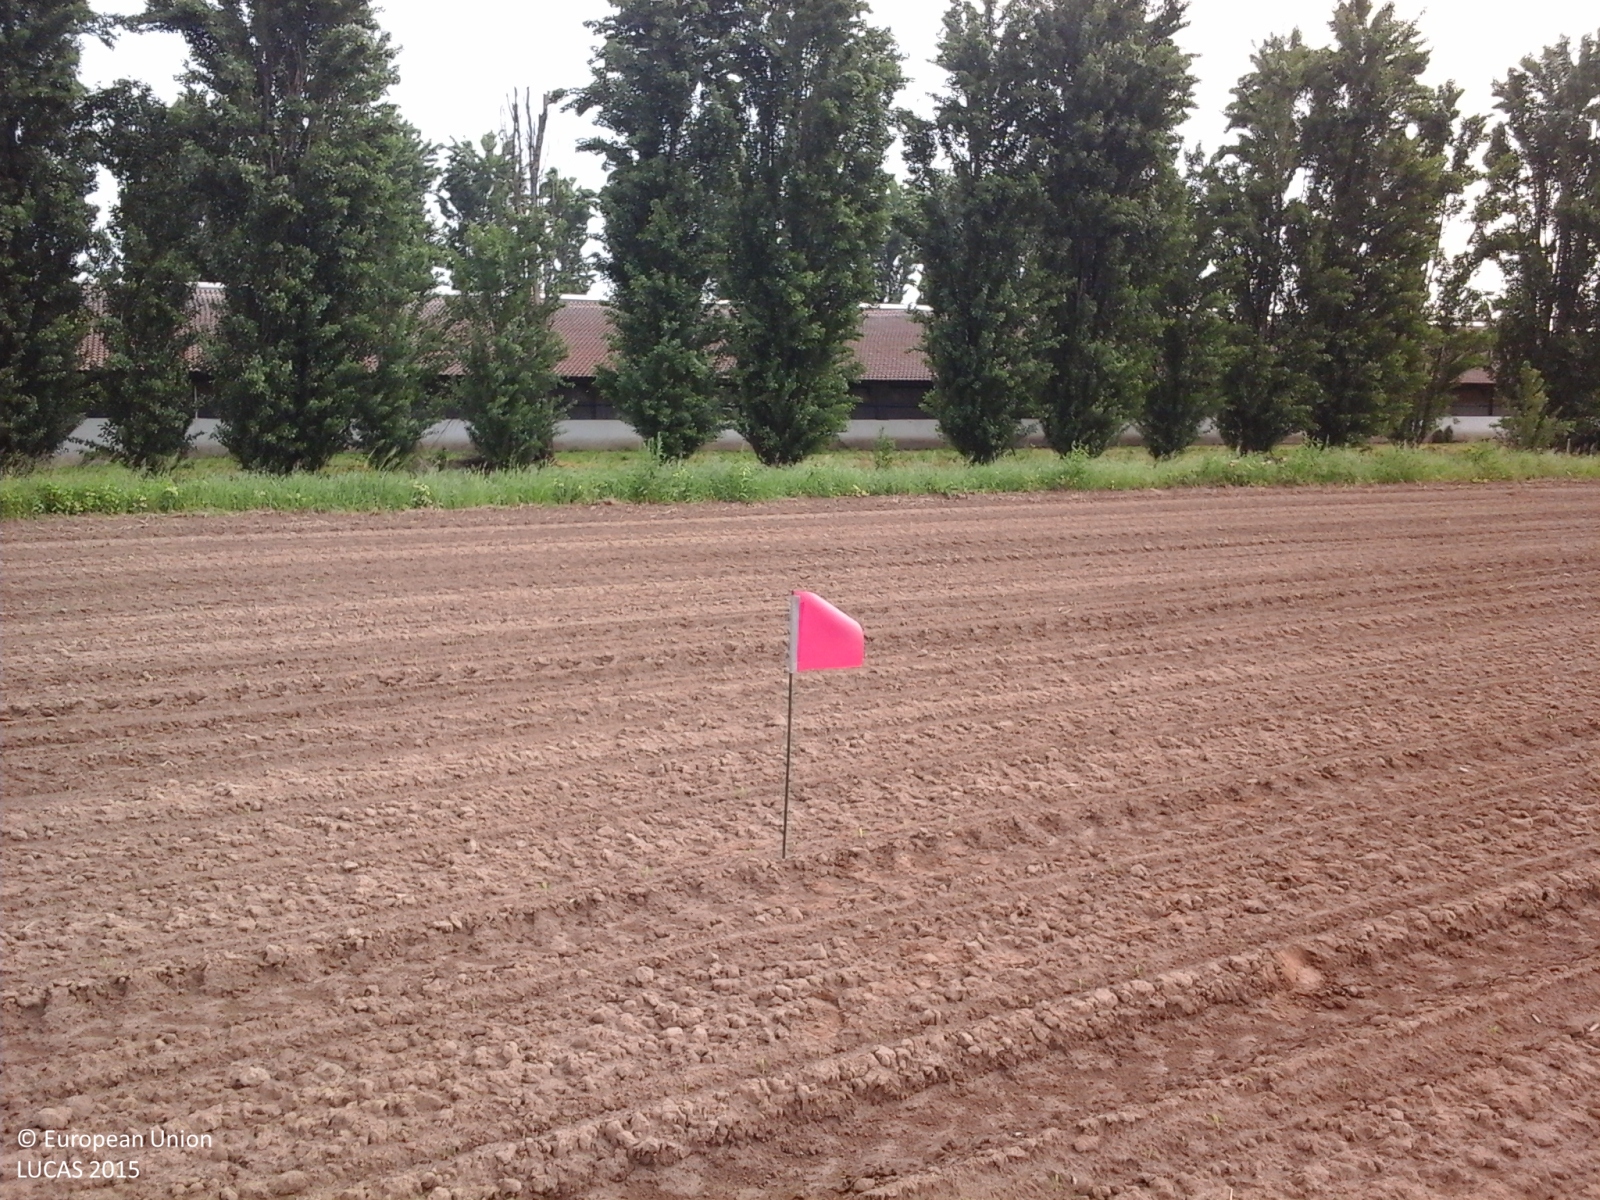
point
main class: Cropland
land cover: Maize
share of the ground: < 10 %
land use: Agriculture (excluding fallow land and kitchen gardens)
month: May
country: IT
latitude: 45.0711
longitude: 10.3930
